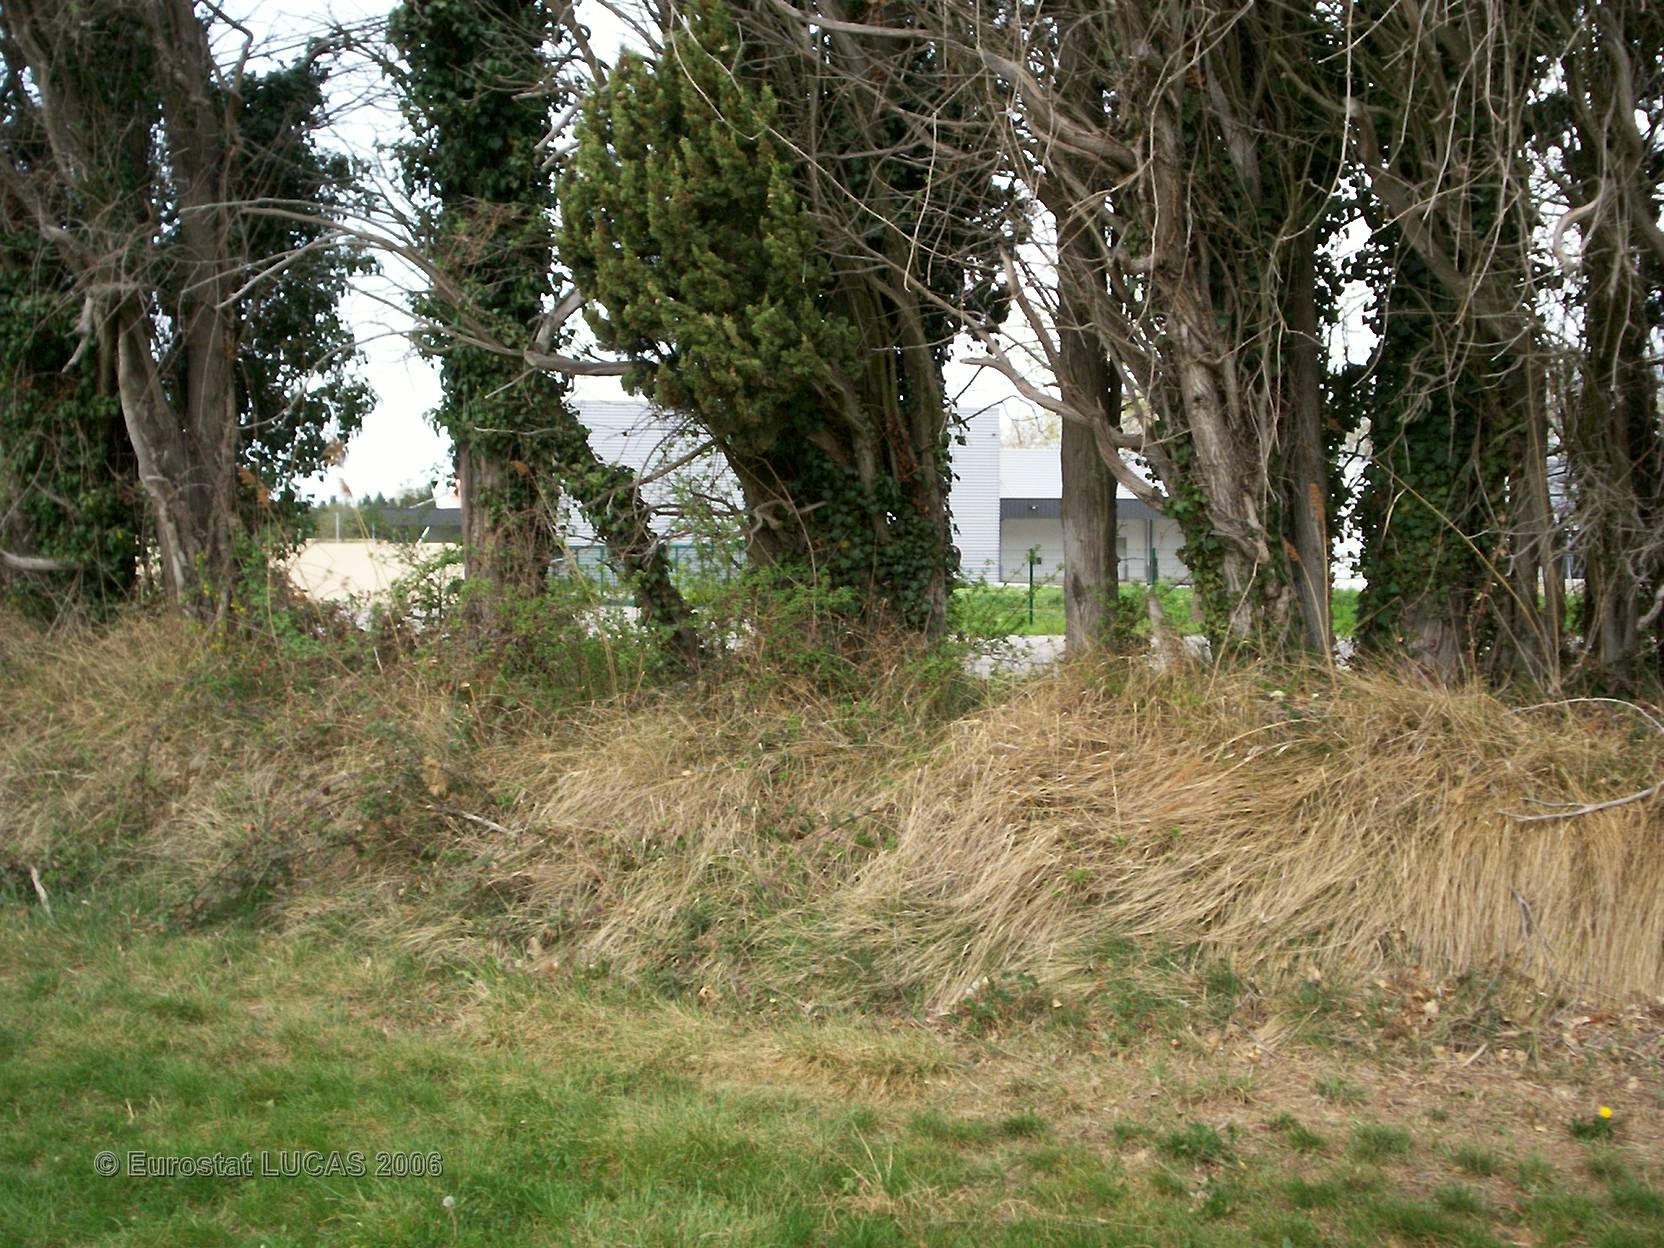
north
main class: Grassland
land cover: Grassland without tree/shrub cover
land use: Agriculture (excluding fallow land and kitchen gardens)
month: April
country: FR
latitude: 43.8312
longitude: 4.9725
